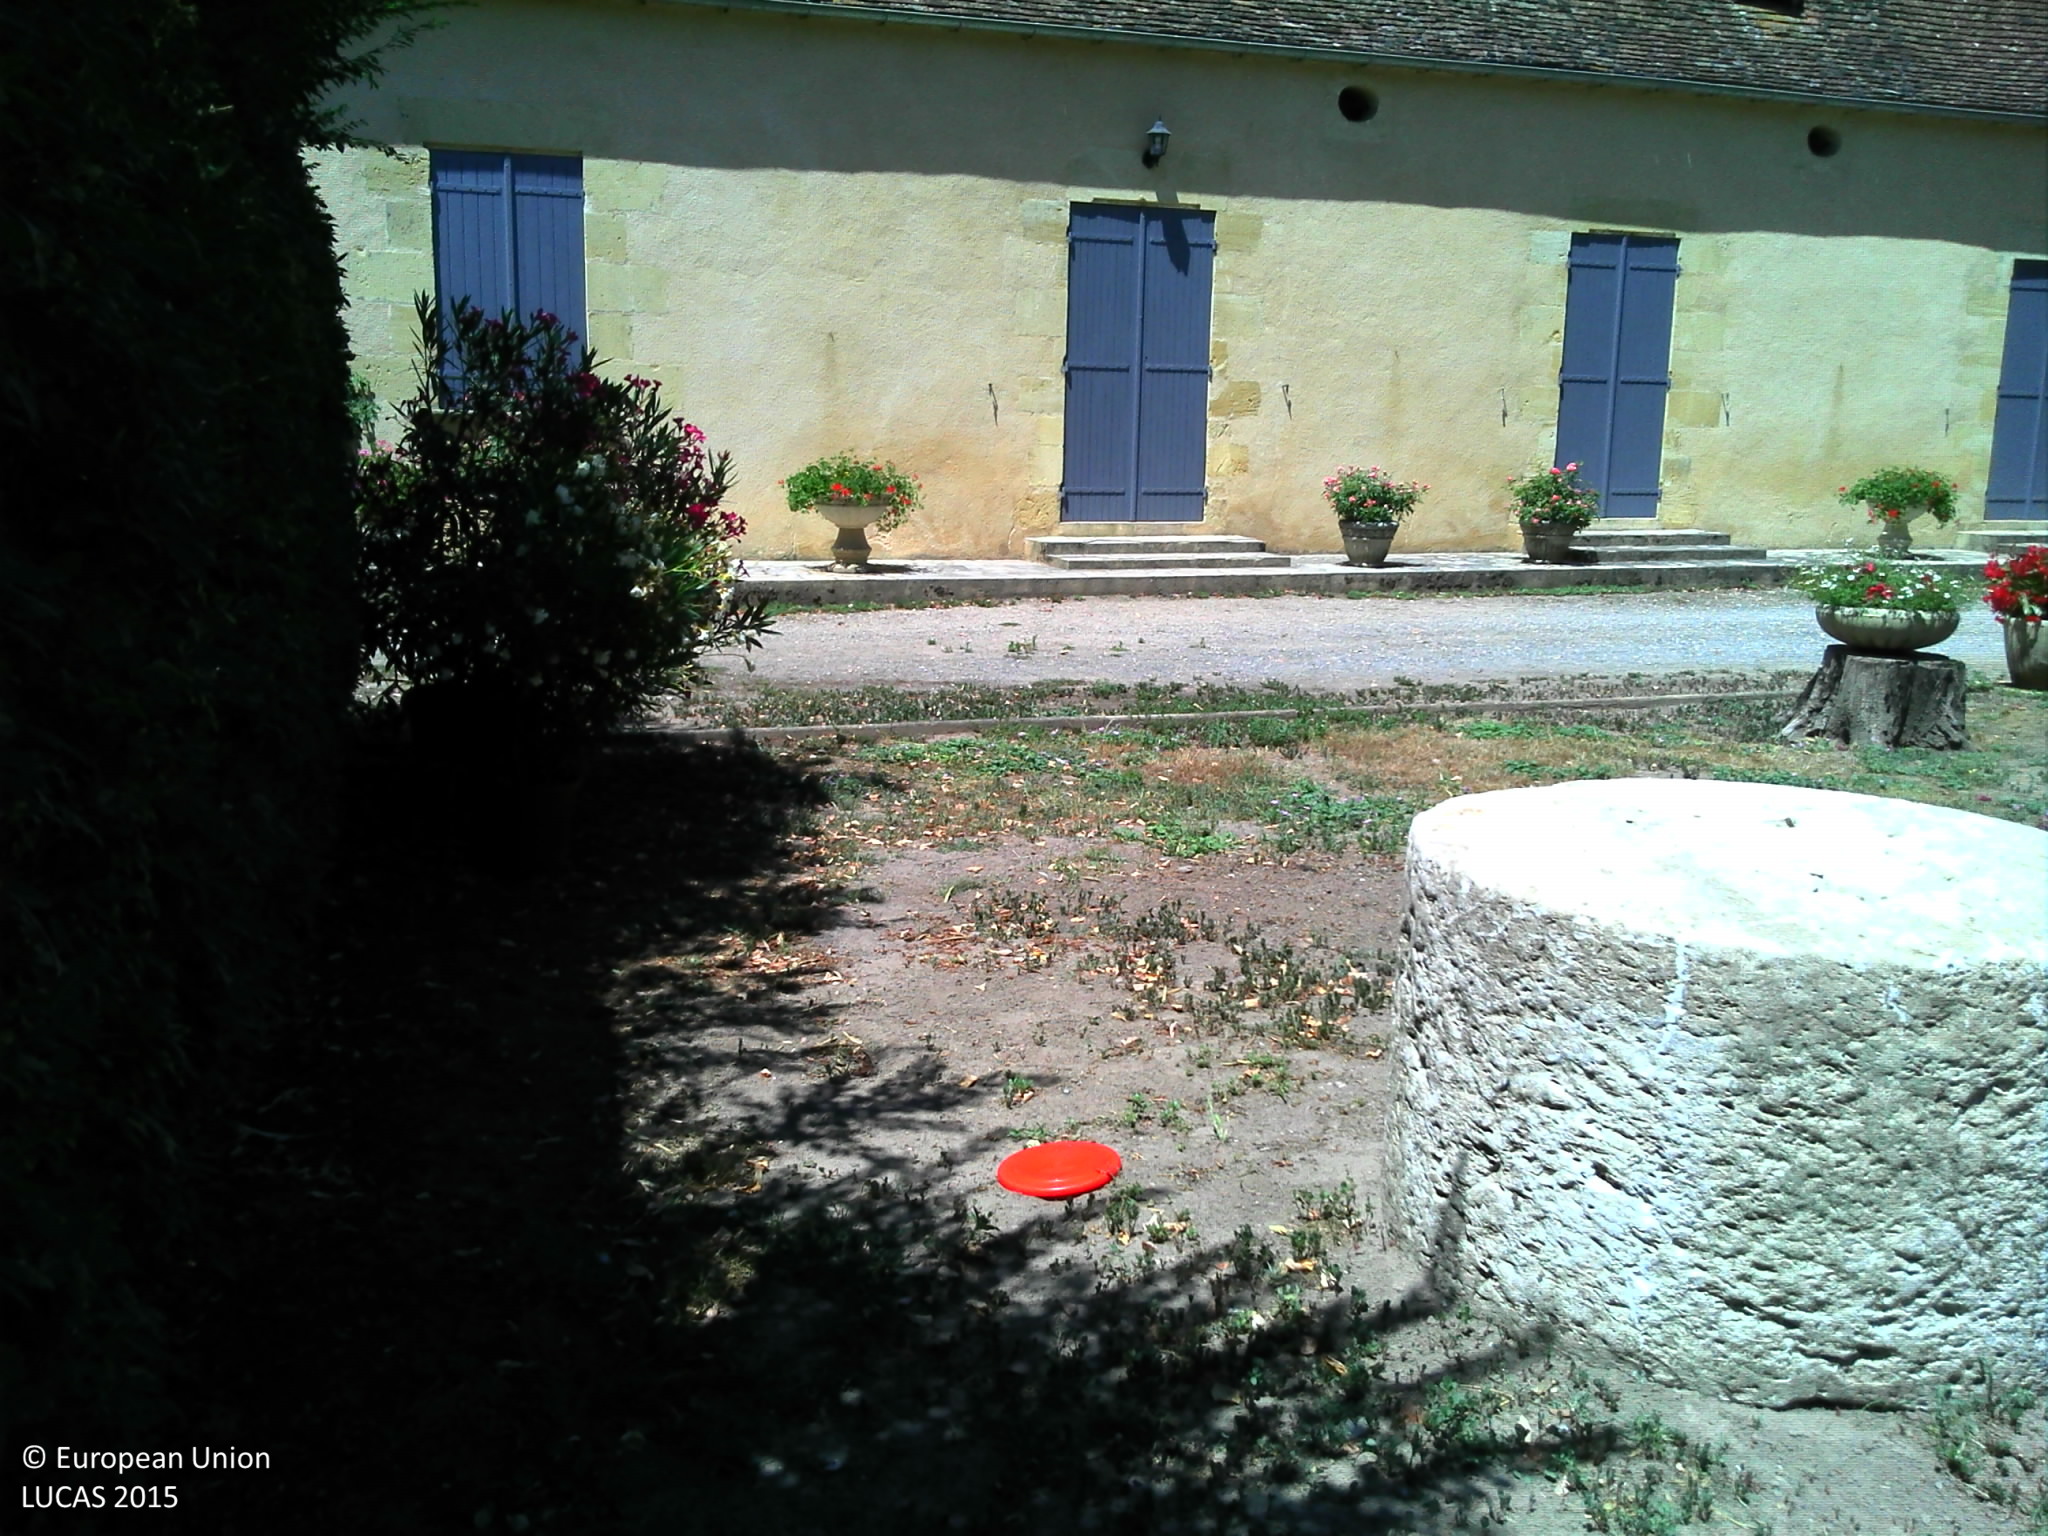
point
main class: Grassland
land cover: Grassland with sparse tree/shrub cover
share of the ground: > 75 %
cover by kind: herbaceous plants 75 %, unconsolidated bare surface 15 %, broadleaved forest trees 5 %, shrubs 5 %
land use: Residential
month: July
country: FR
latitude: 44.8430
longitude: 0.5401
